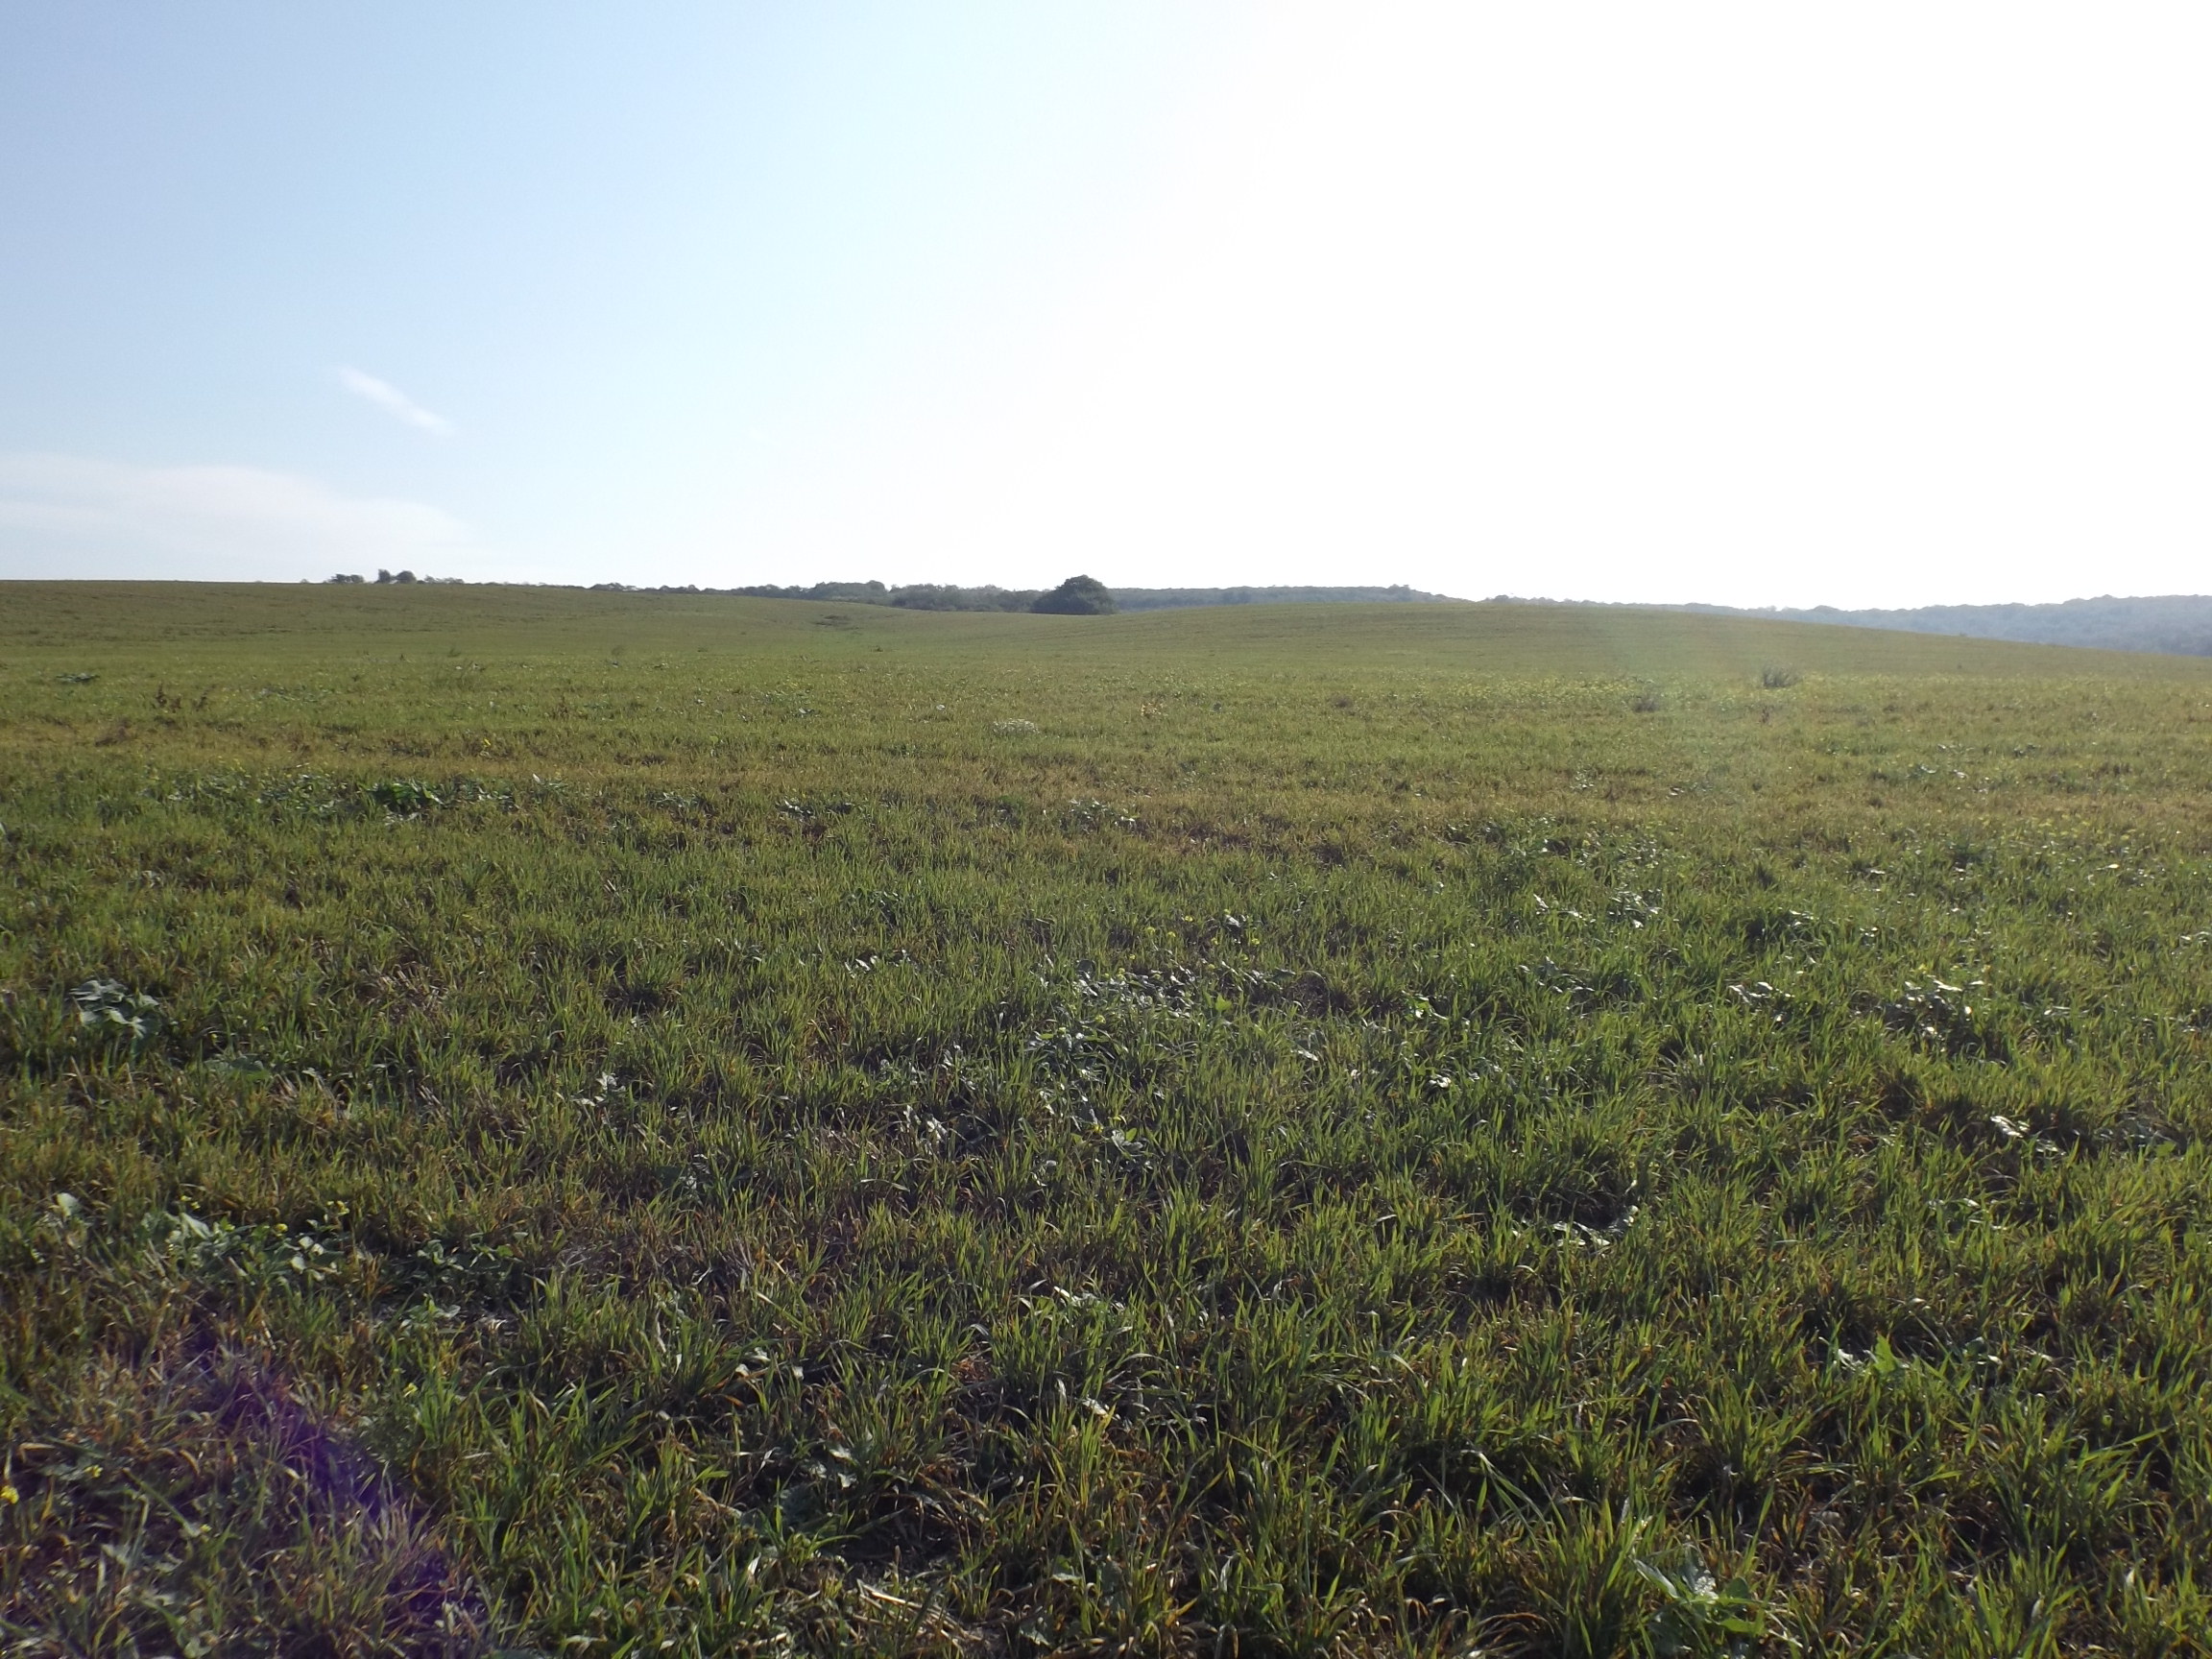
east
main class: Cropland
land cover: Common wheat
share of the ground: < 10 %
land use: Agriculture (excluding fallow land and kitchen gardens)
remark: Harvested field
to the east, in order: Common wheat
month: October
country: BG
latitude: 43.1573
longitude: 27.5294
